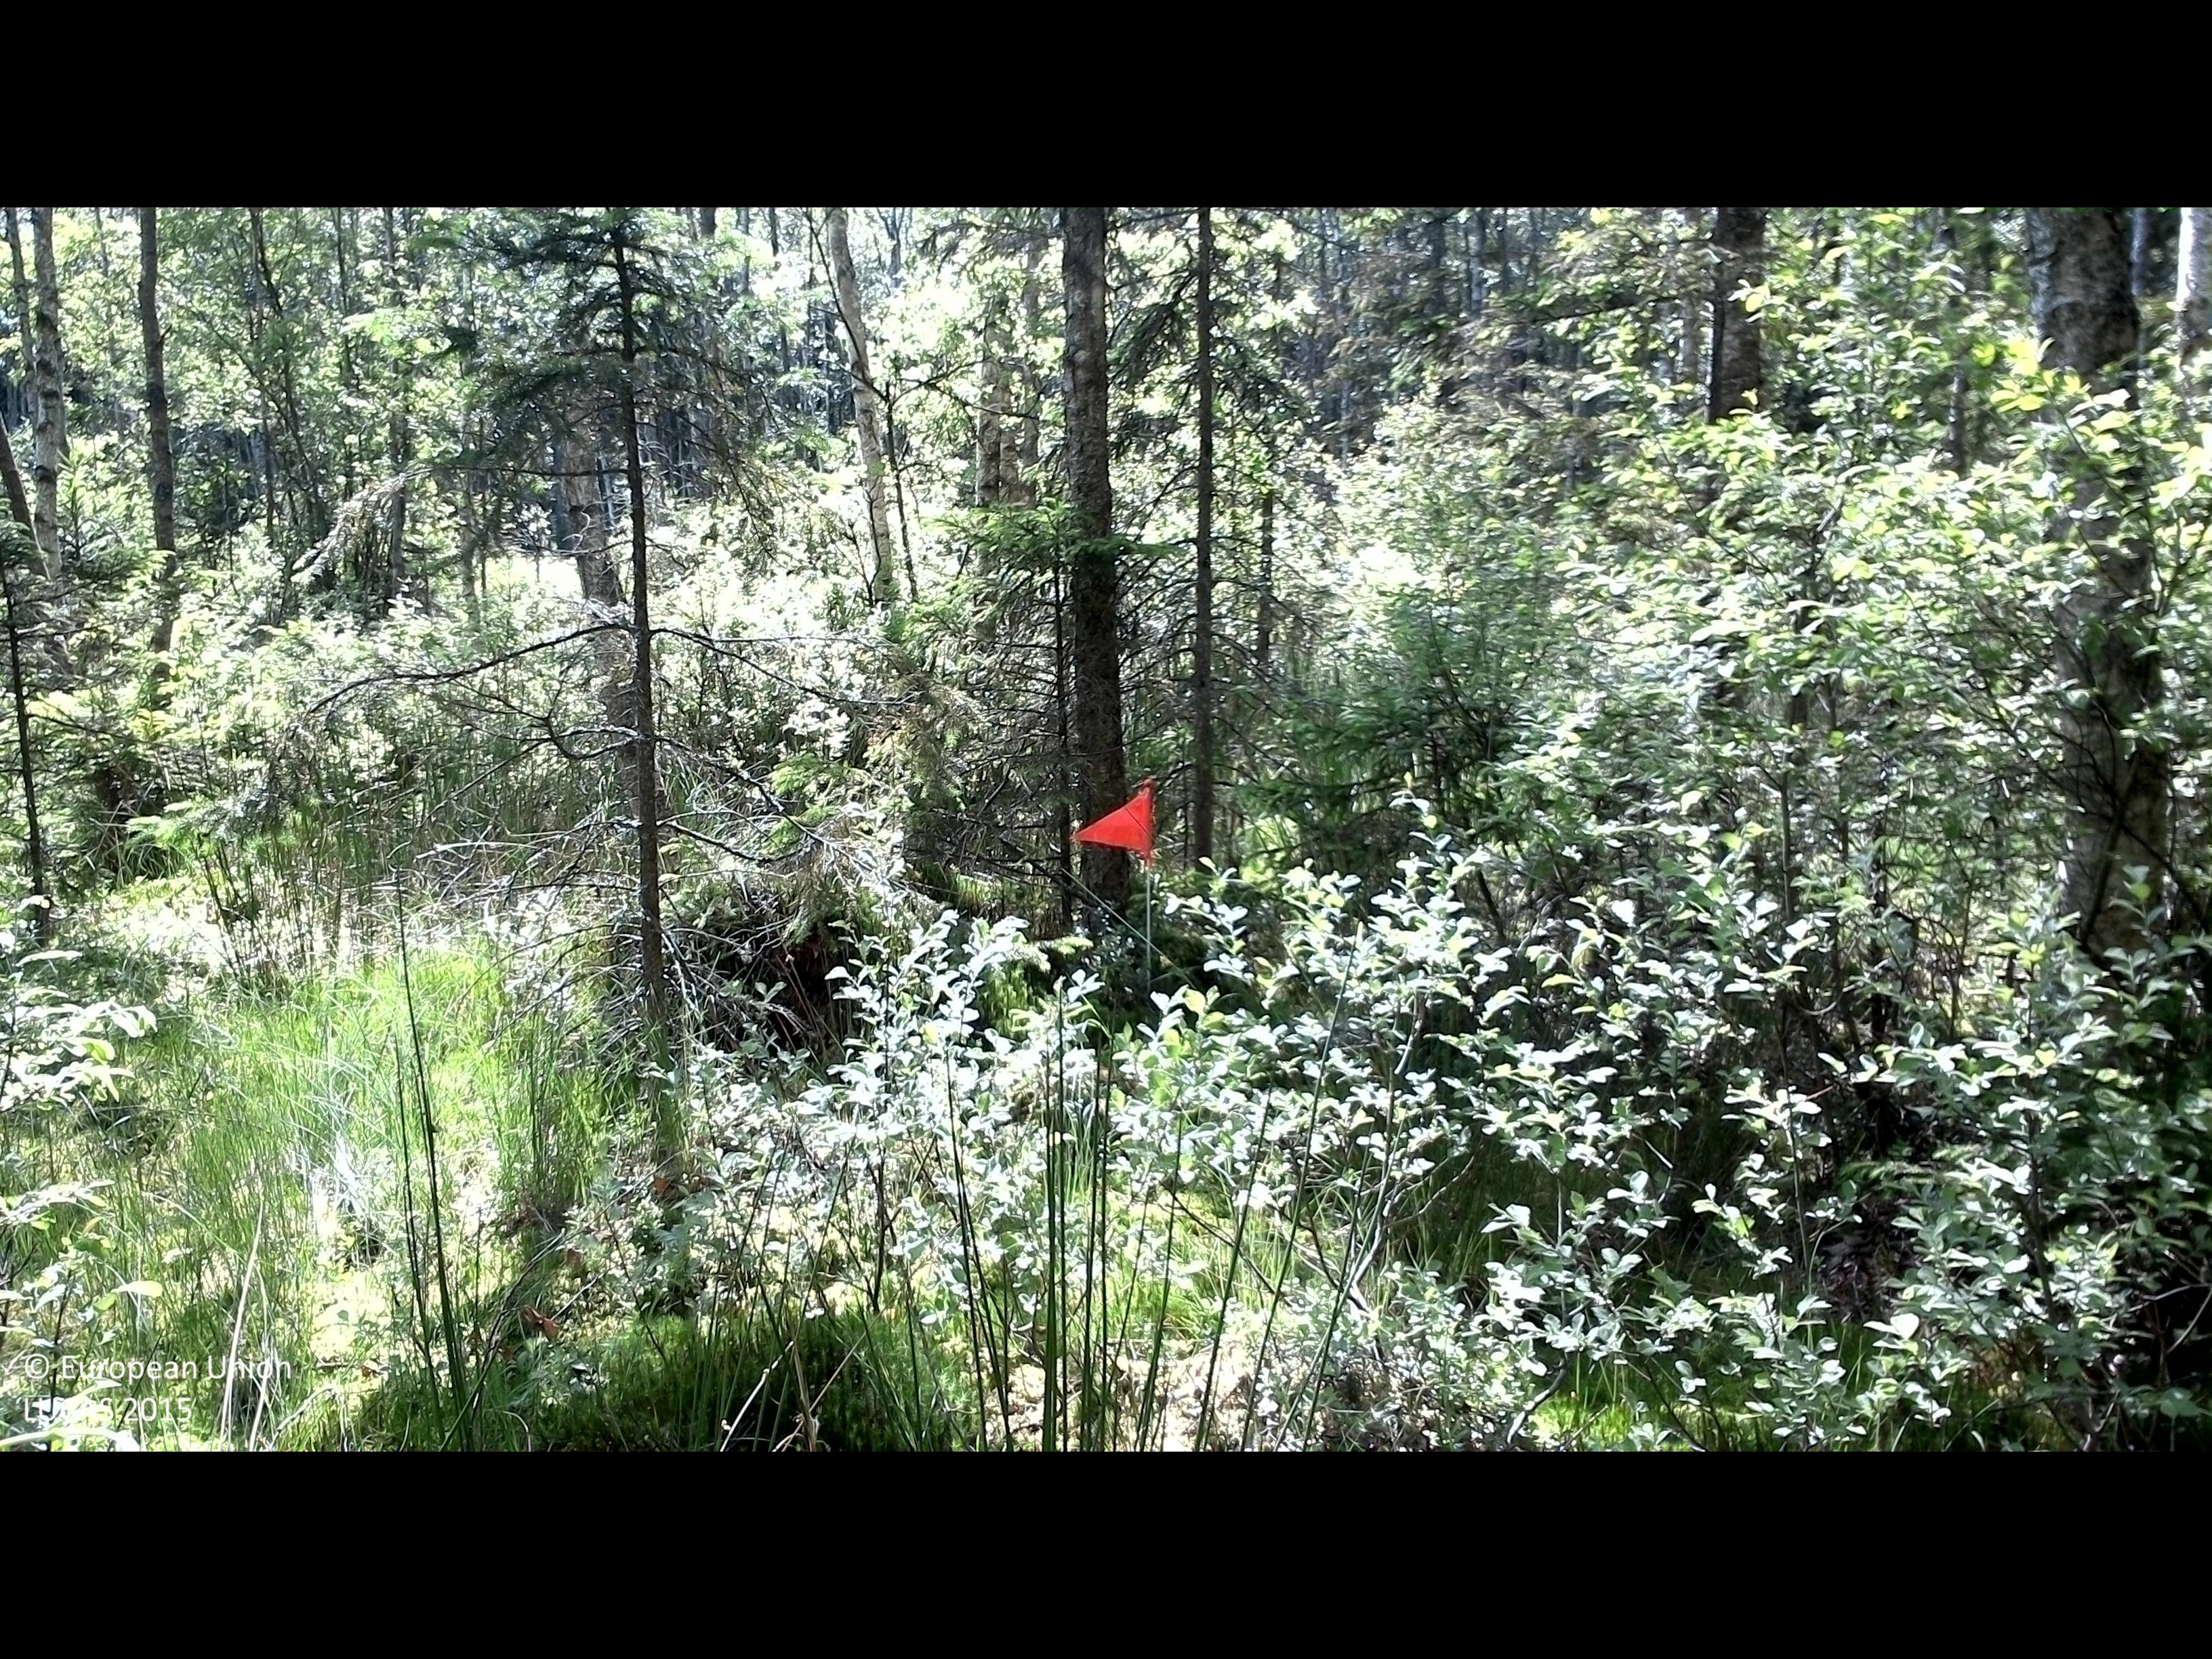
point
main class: Woodland
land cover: Broadleaved woodland
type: boreal forest
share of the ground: 50 - 75 %
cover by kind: broadleaved forest trees 50 %, lichens and mosses 25 %, coniferous forest trees 10 %, herbaceous plants 10 %, shrubs 5 %
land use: Forestry
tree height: > 5 m
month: July
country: SE
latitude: 56.4260
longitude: 15.1707
